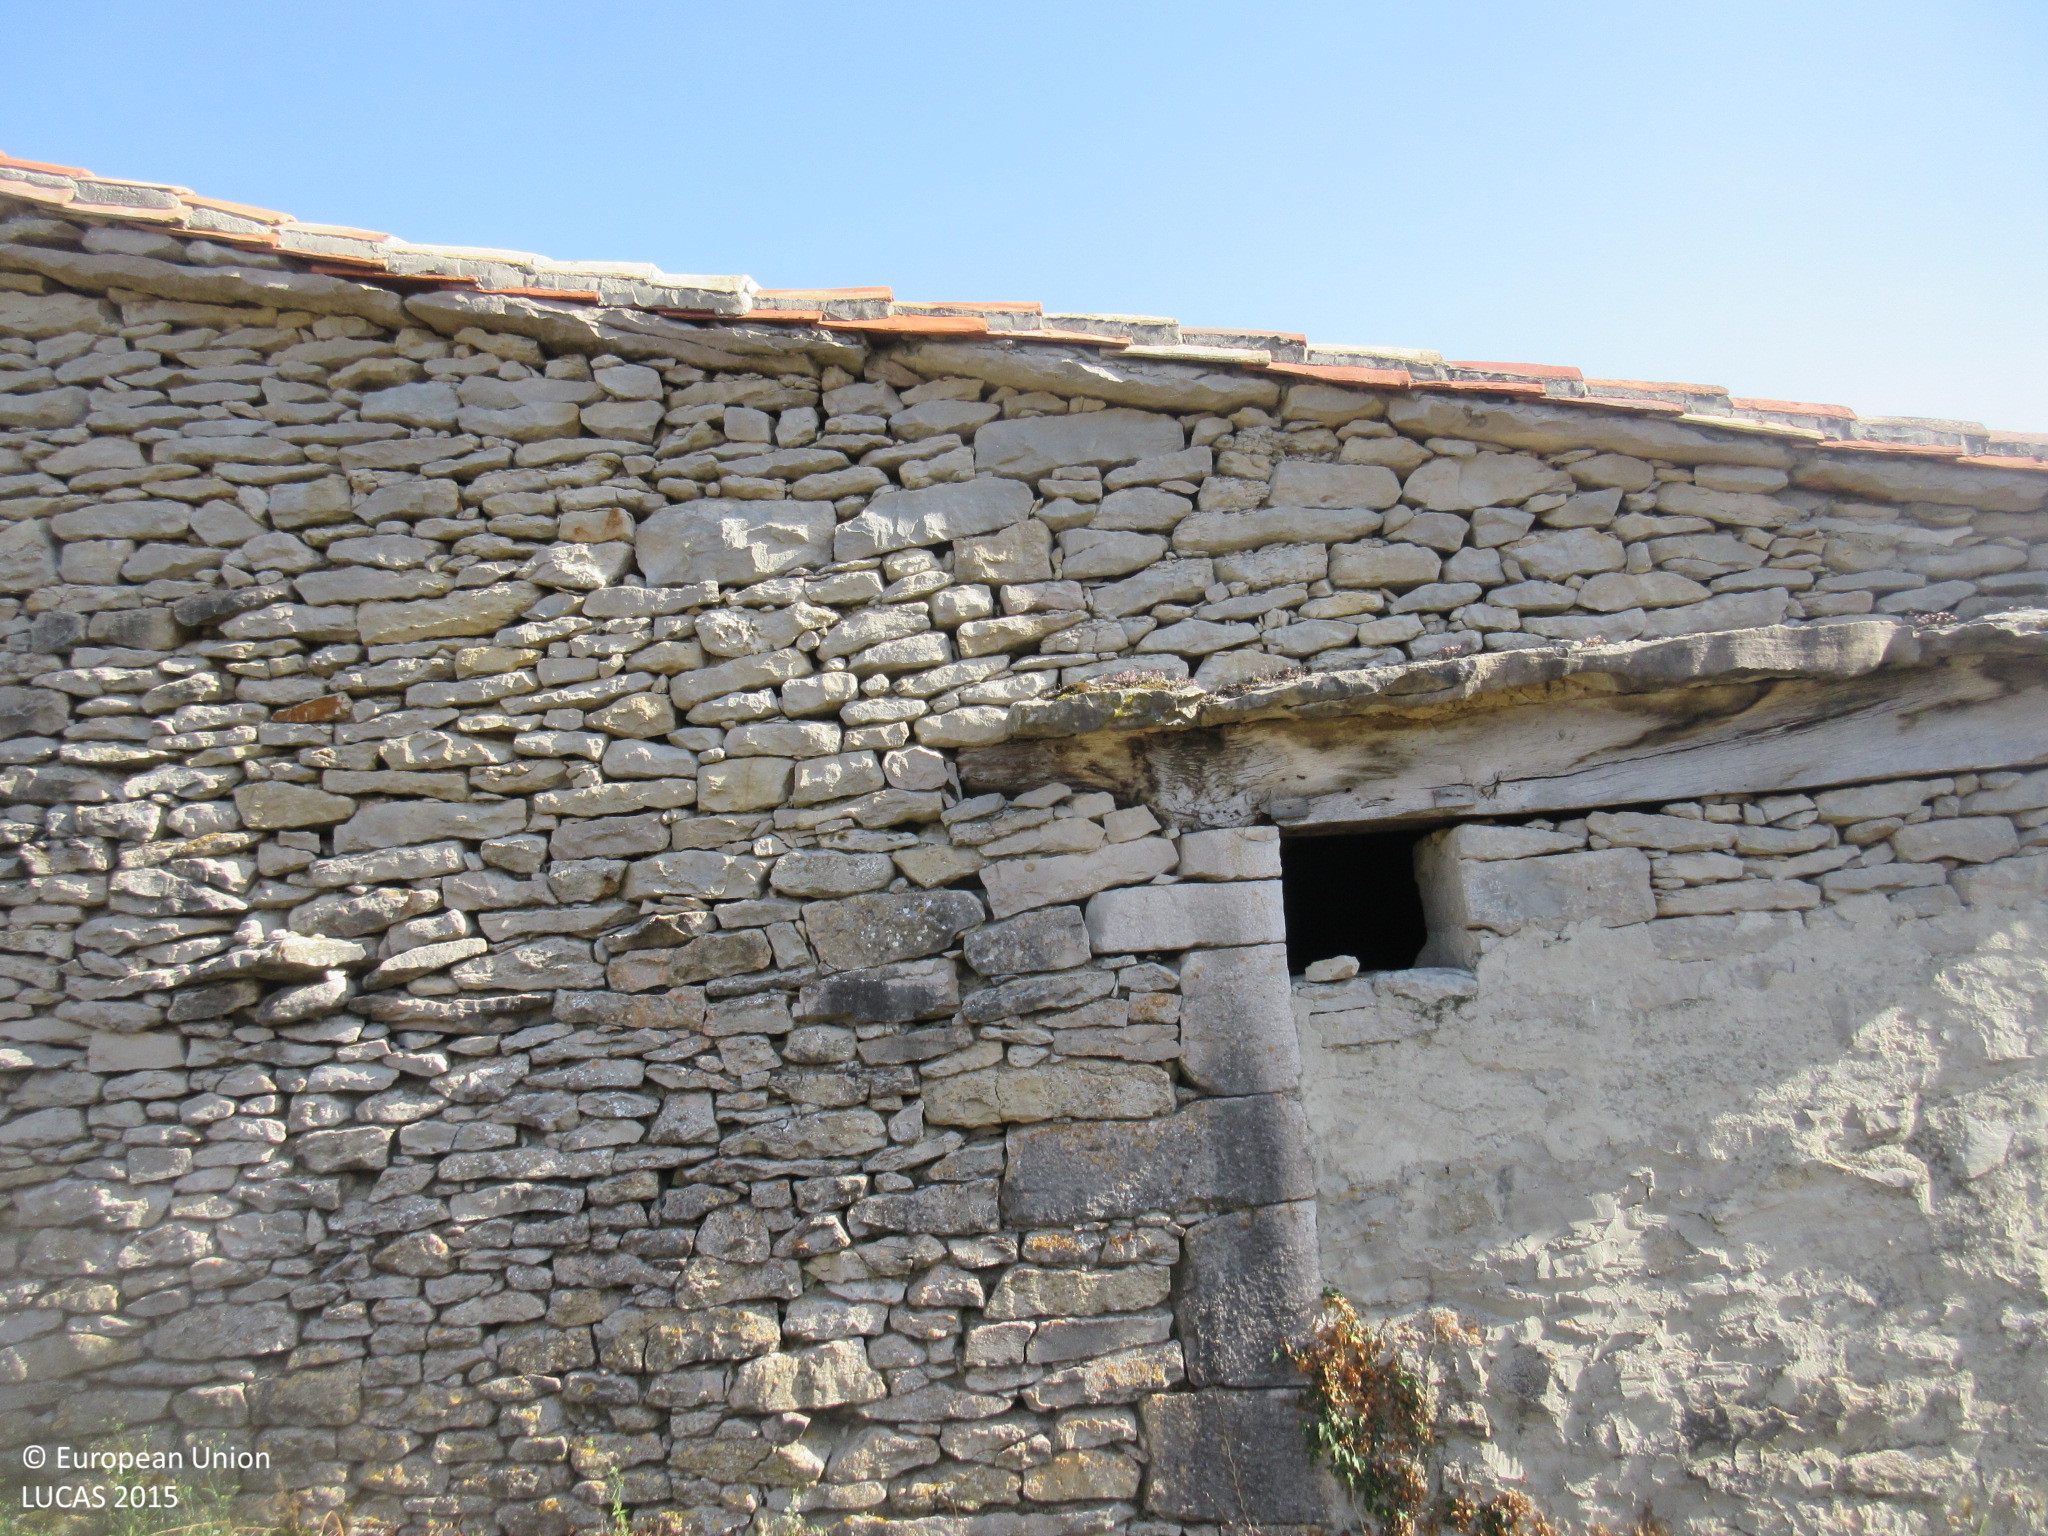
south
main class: Grassland
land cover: Spontaneously vegetated surfaces
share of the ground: > 75 %
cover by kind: herbaceous plants 100 %
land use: Semi-natural and natural areas not in use
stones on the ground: > 50 %
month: July
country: ES
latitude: 43.0523
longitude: -3.4338
